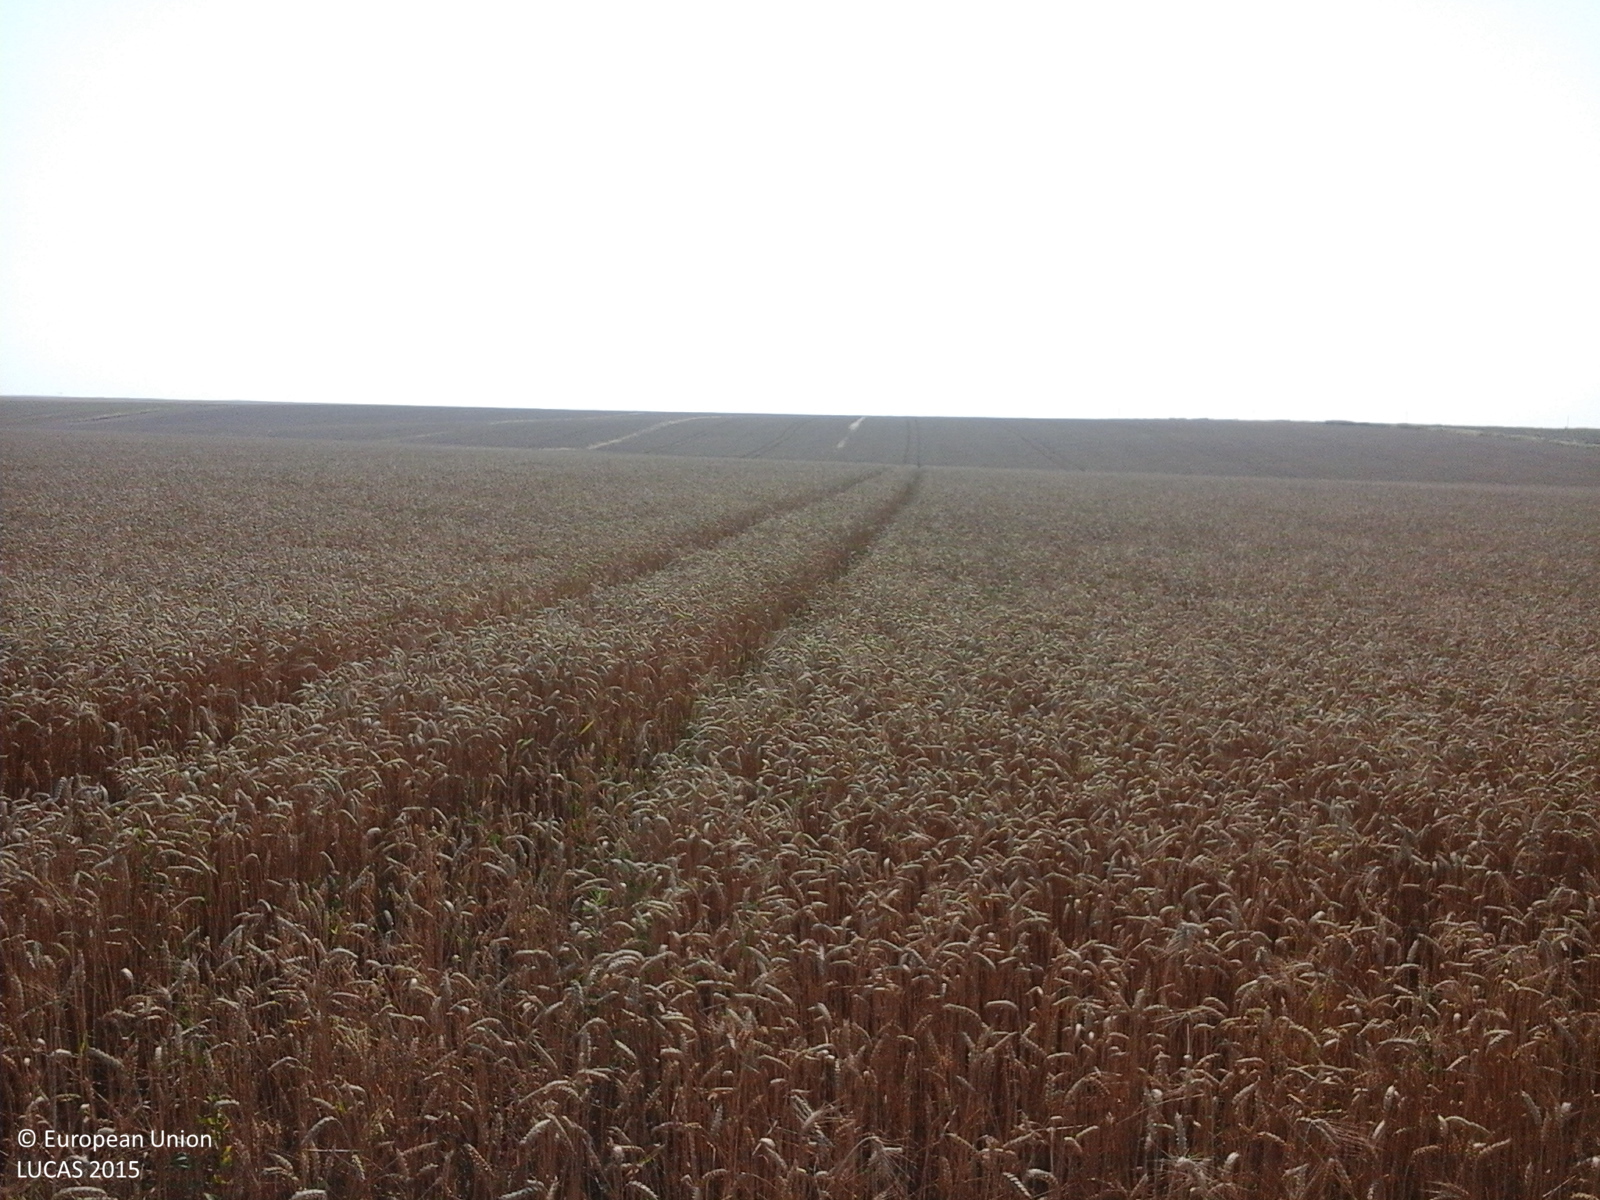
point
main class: Cropland
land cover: Common wheat
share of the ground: > 75 %
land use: Agriculture (excluding fallow land and kitchen gardens)
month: July
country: RO
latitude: 44.6245
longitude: 24.5036
